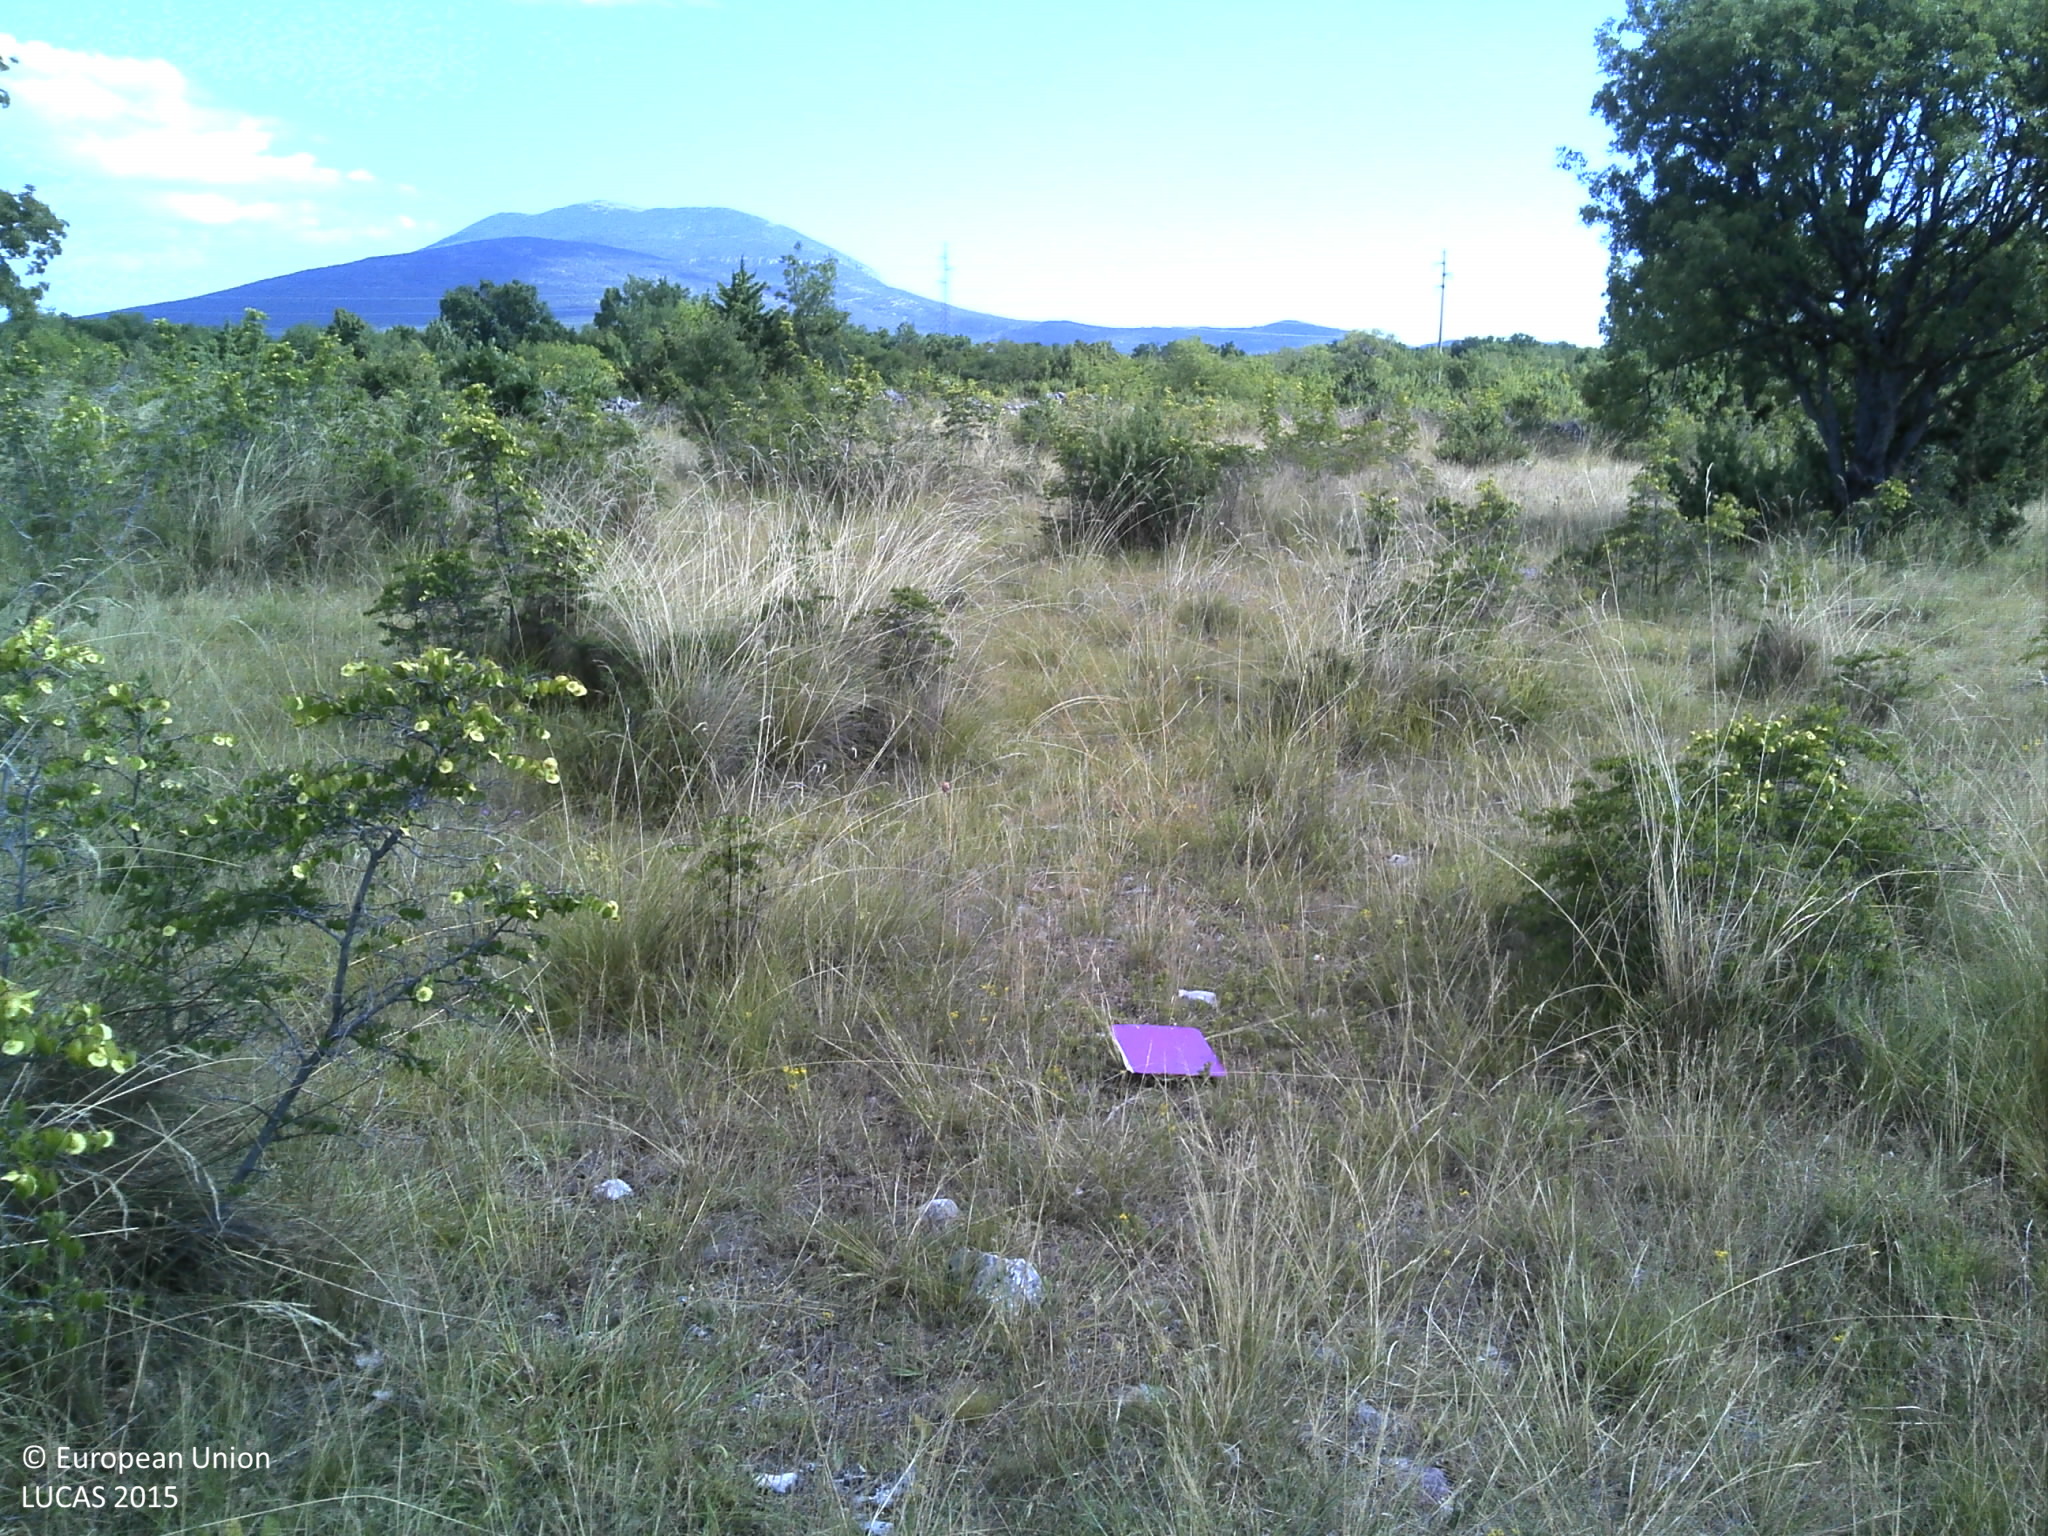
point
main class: Shrubland
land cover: Shrubland with sparse tree cover
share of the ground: 50 - 75 %
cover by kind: shrubs 55 %, herbaceous plants 35 %, broadleaved forest trees 5 %, consolidated bare surface 5 %
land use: Semi-natural and natural areas not in use
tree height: < 5 m
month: July
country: HR
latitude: 44.0073
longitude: 16.1162
